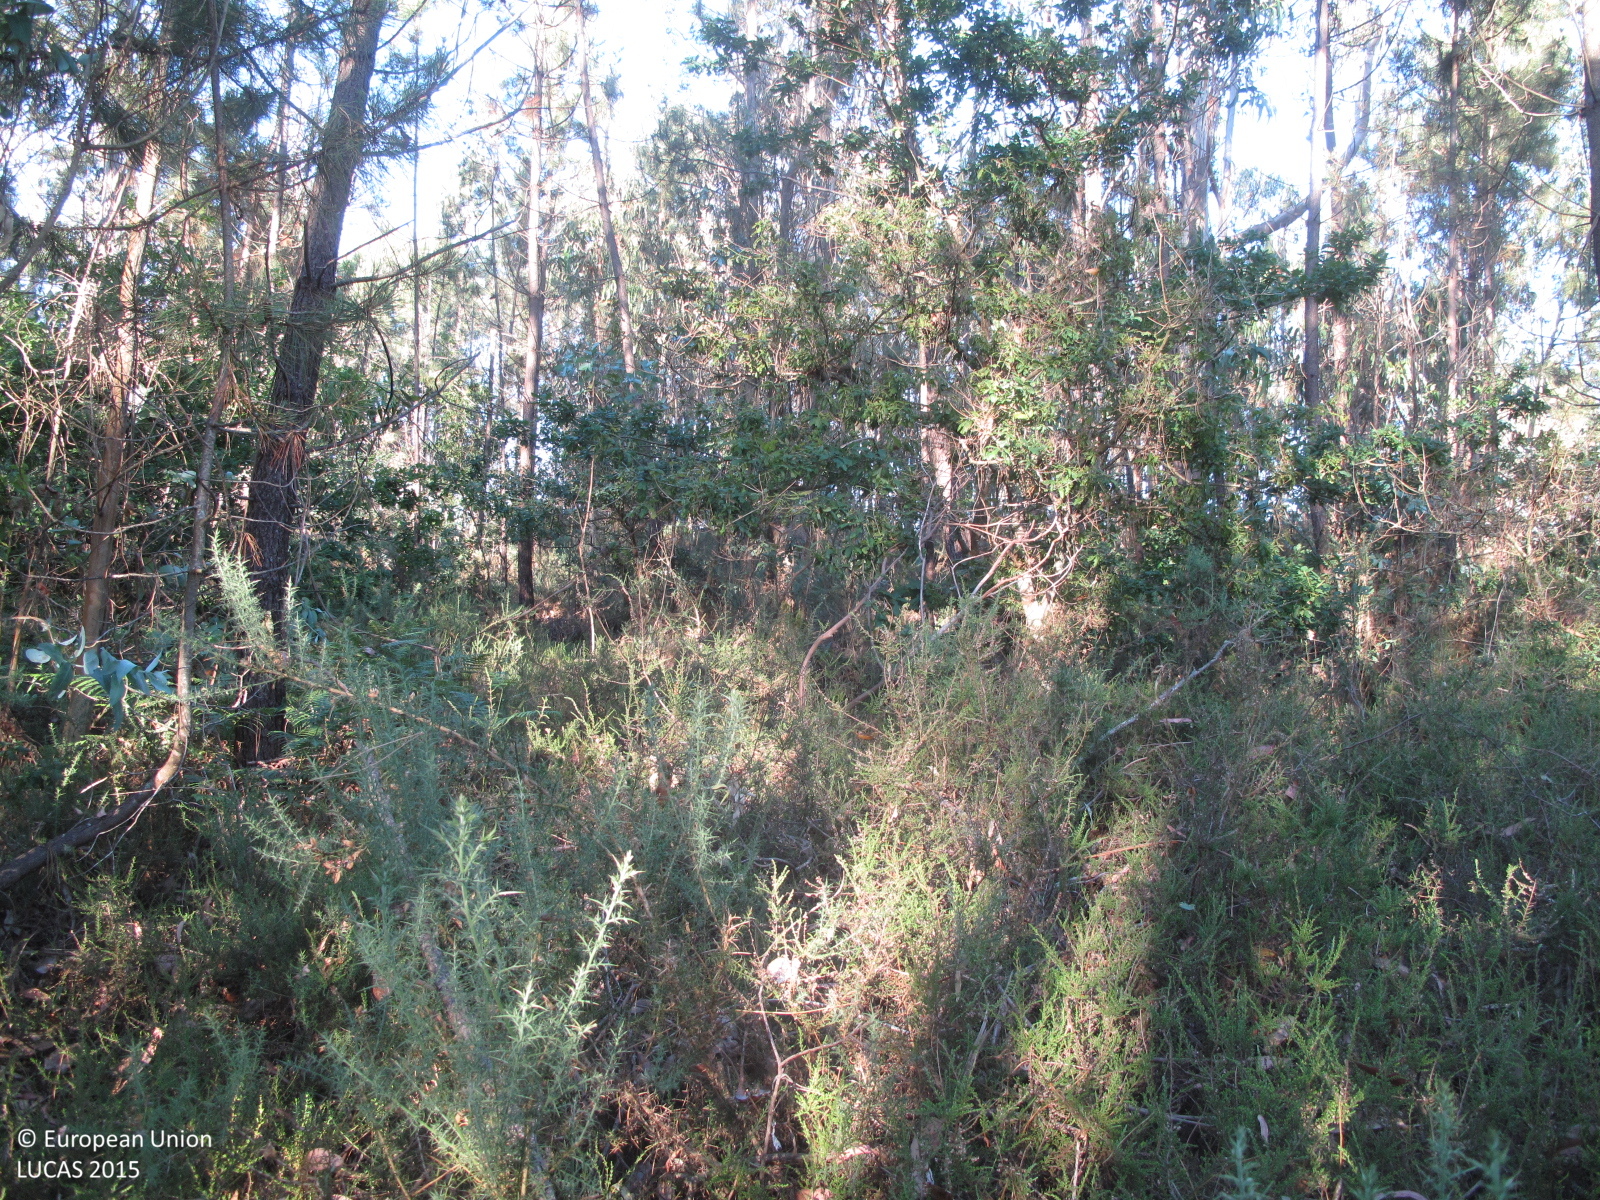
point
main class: Woodland
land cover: Other mixed woodland
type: exotic forest
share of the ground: 50 - 75 %
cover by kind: broadleaved forest trees 40 %, coniferous forest trees 30 %, shrubs 20 %, herbaceous plants 10 %
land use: Forestry
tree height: > 5 m
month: June
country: ES
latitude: 42.9720
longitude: -8.5596
